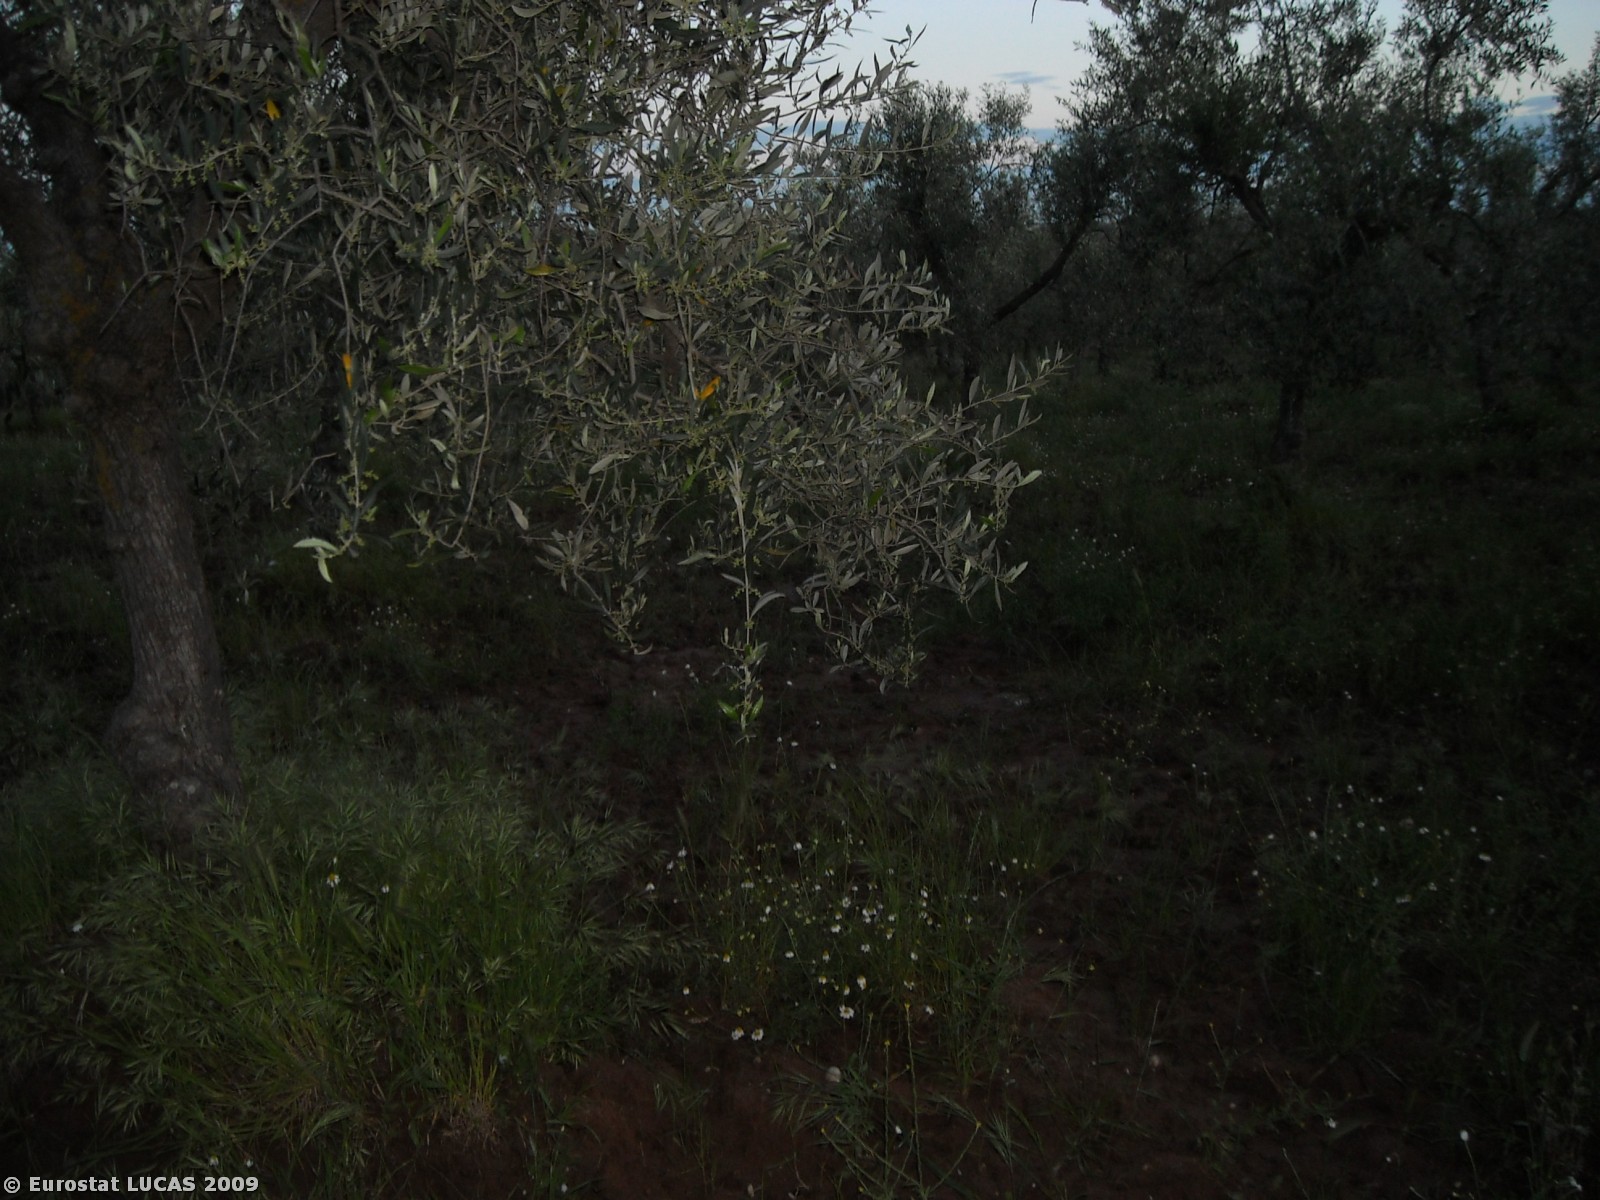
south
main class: Cropland
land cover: Olive groves
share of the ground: 25 - 50 %
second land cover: Spontaneously vegetated surfaces
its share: > 75 %
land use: Agriculture (excluding fallow land and kitchen gardens)
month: April
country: IT
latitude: 40.5501
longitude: 16.9077
